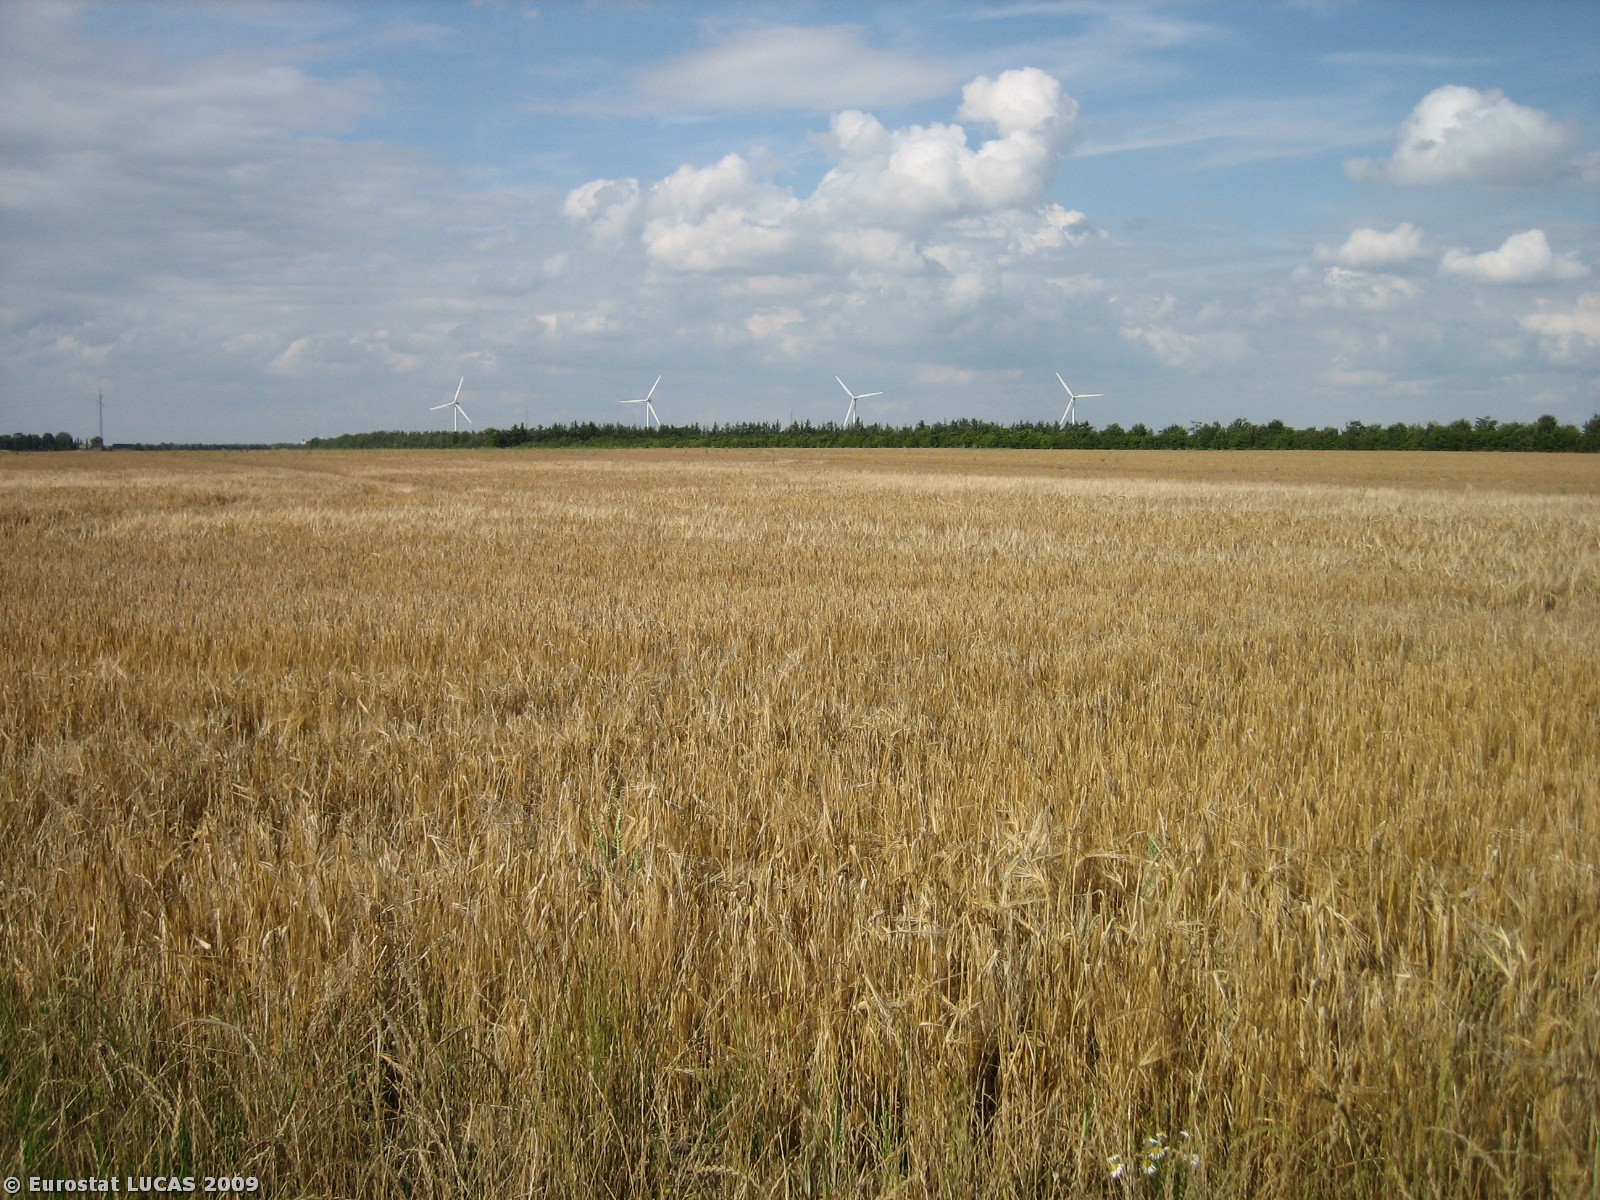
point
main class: Cropland
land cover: Barley
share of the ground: > 75 %
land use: Agriculture (excluding fallow land and kitchen gardens)
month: July
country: DK
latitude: 55.7693
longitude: 8.8694
